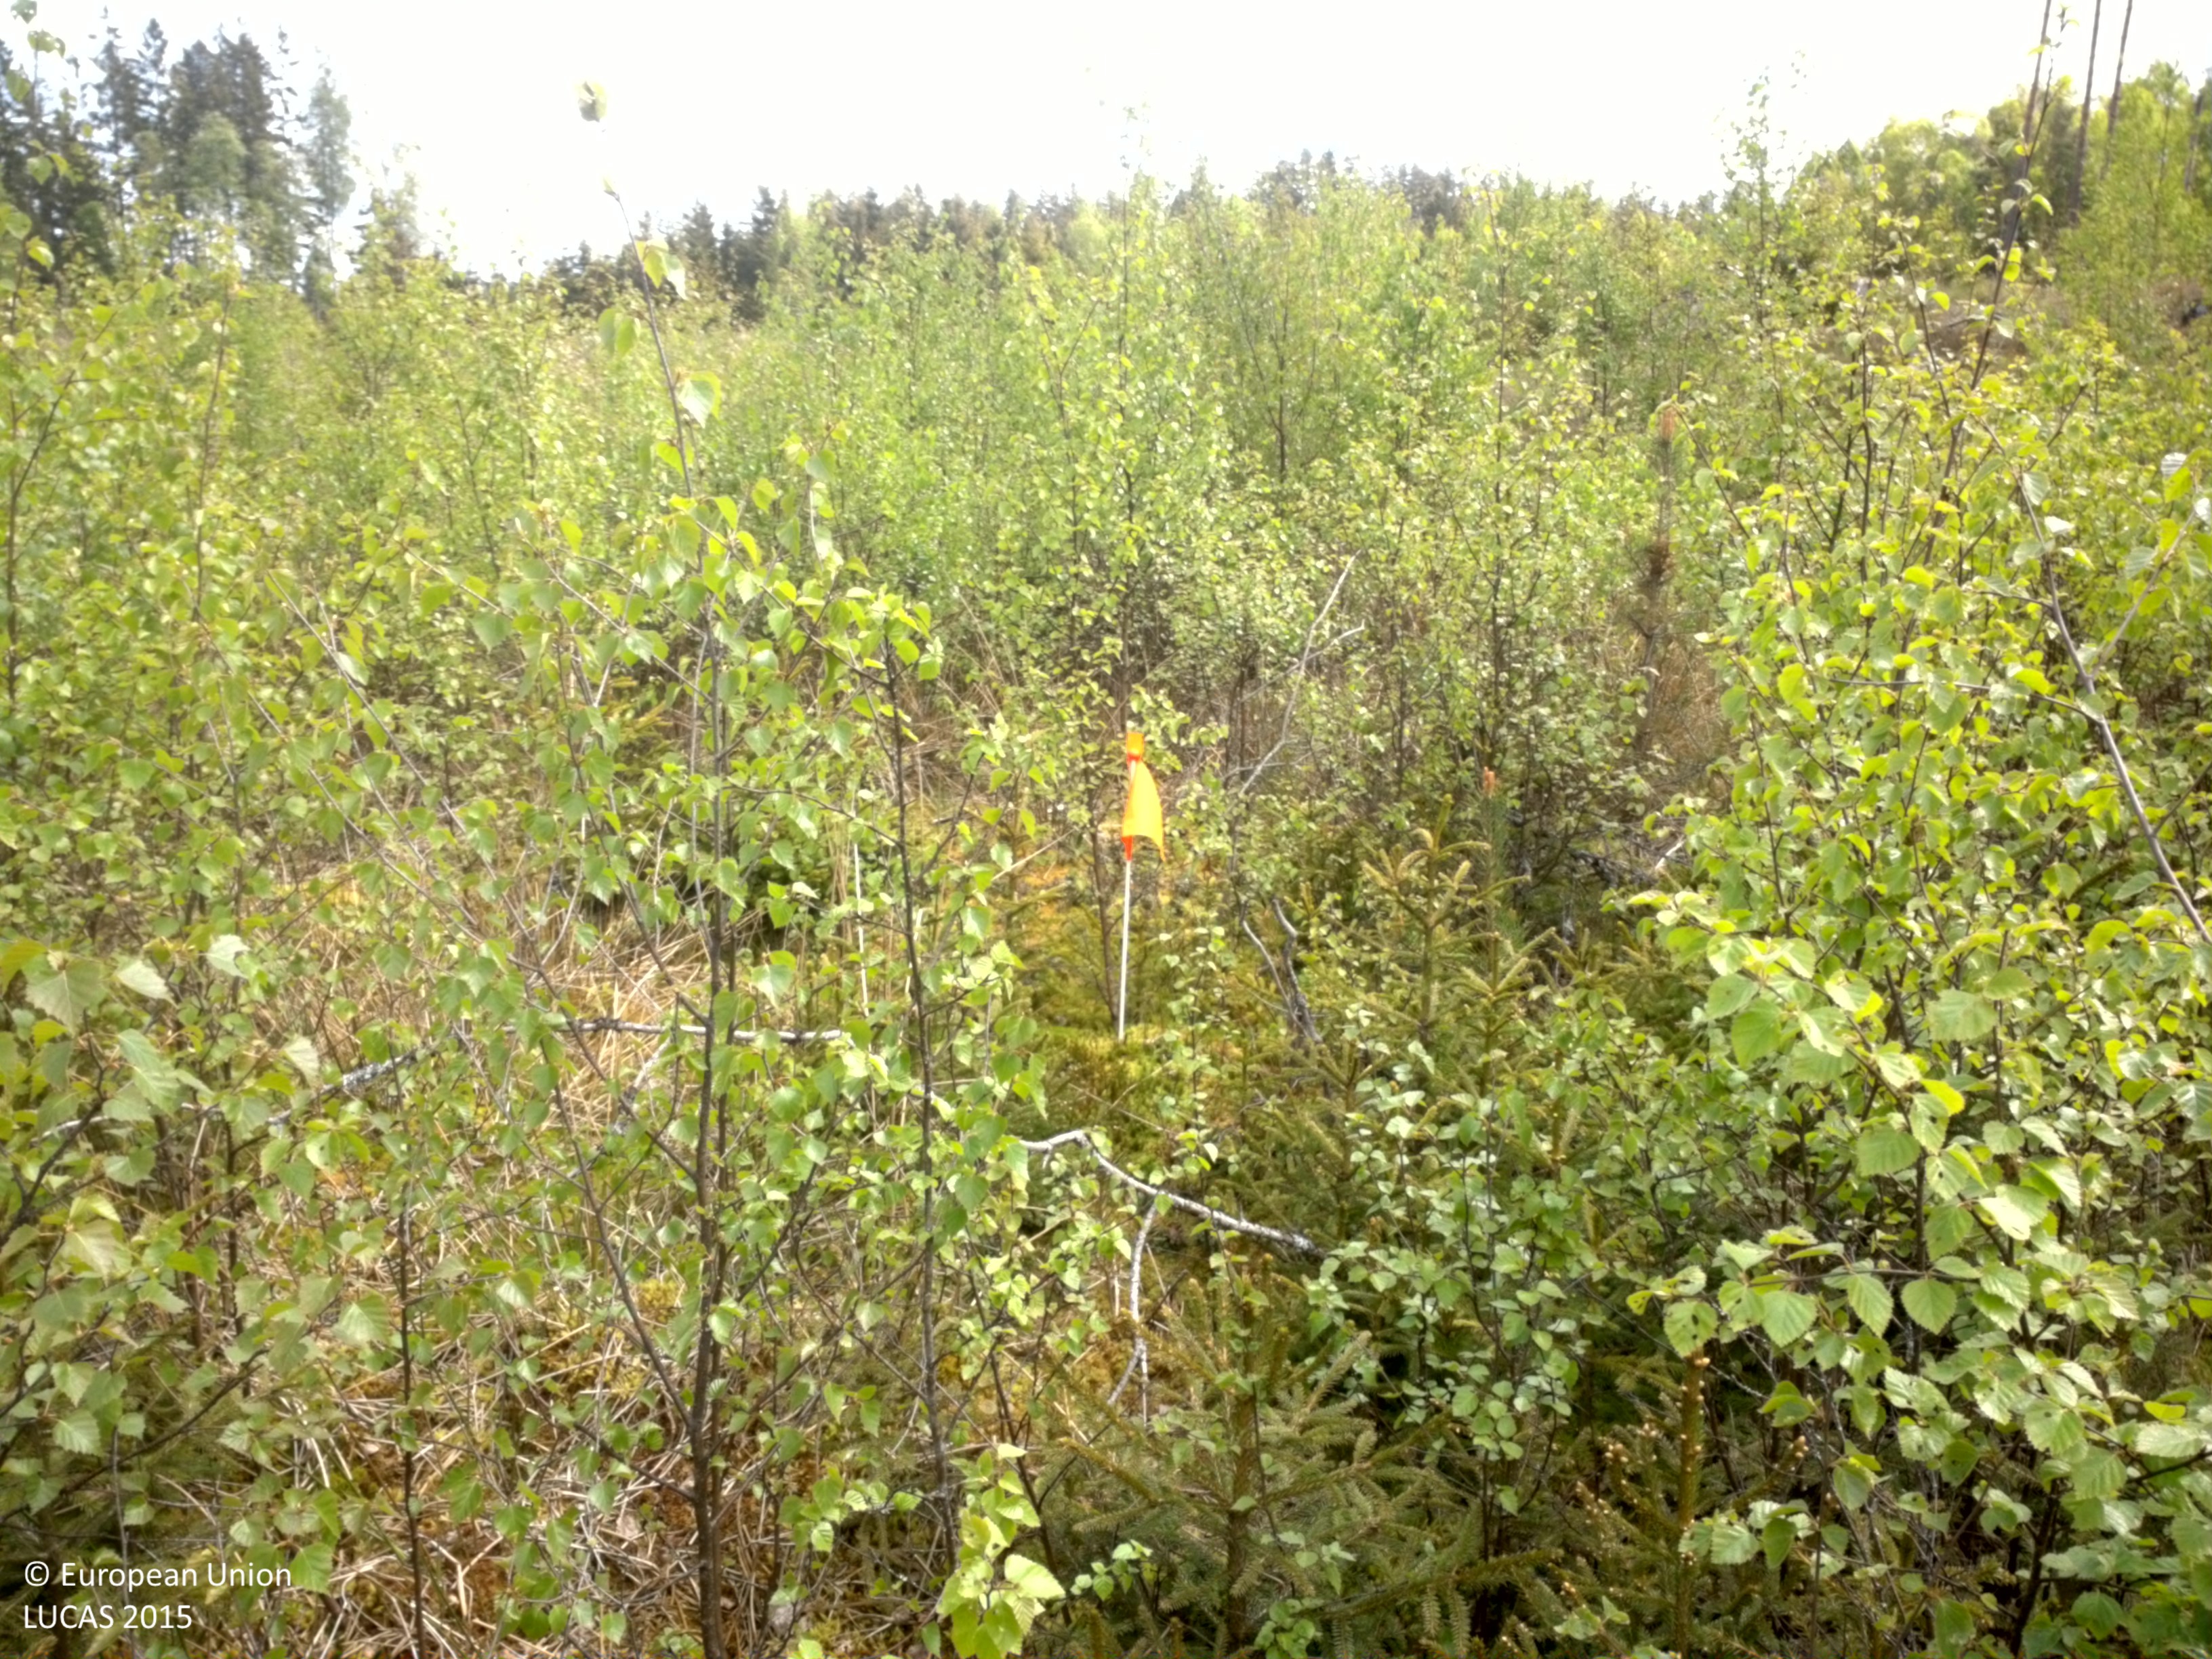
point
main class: Woodland
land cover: Broadleaved woodland
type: hemiboreal forest and nemoral coniferous forest and mixed broadleaved-coniferous forest
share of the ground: > 75 %
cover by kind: broadleaved forest trees 80 %, coniferous forest trees 10 %, shrubs 10 %
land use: Forestry
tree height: < 5 m
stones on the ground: < 10 %
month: May
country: SE
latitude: 56.5156
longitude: 15.1828
